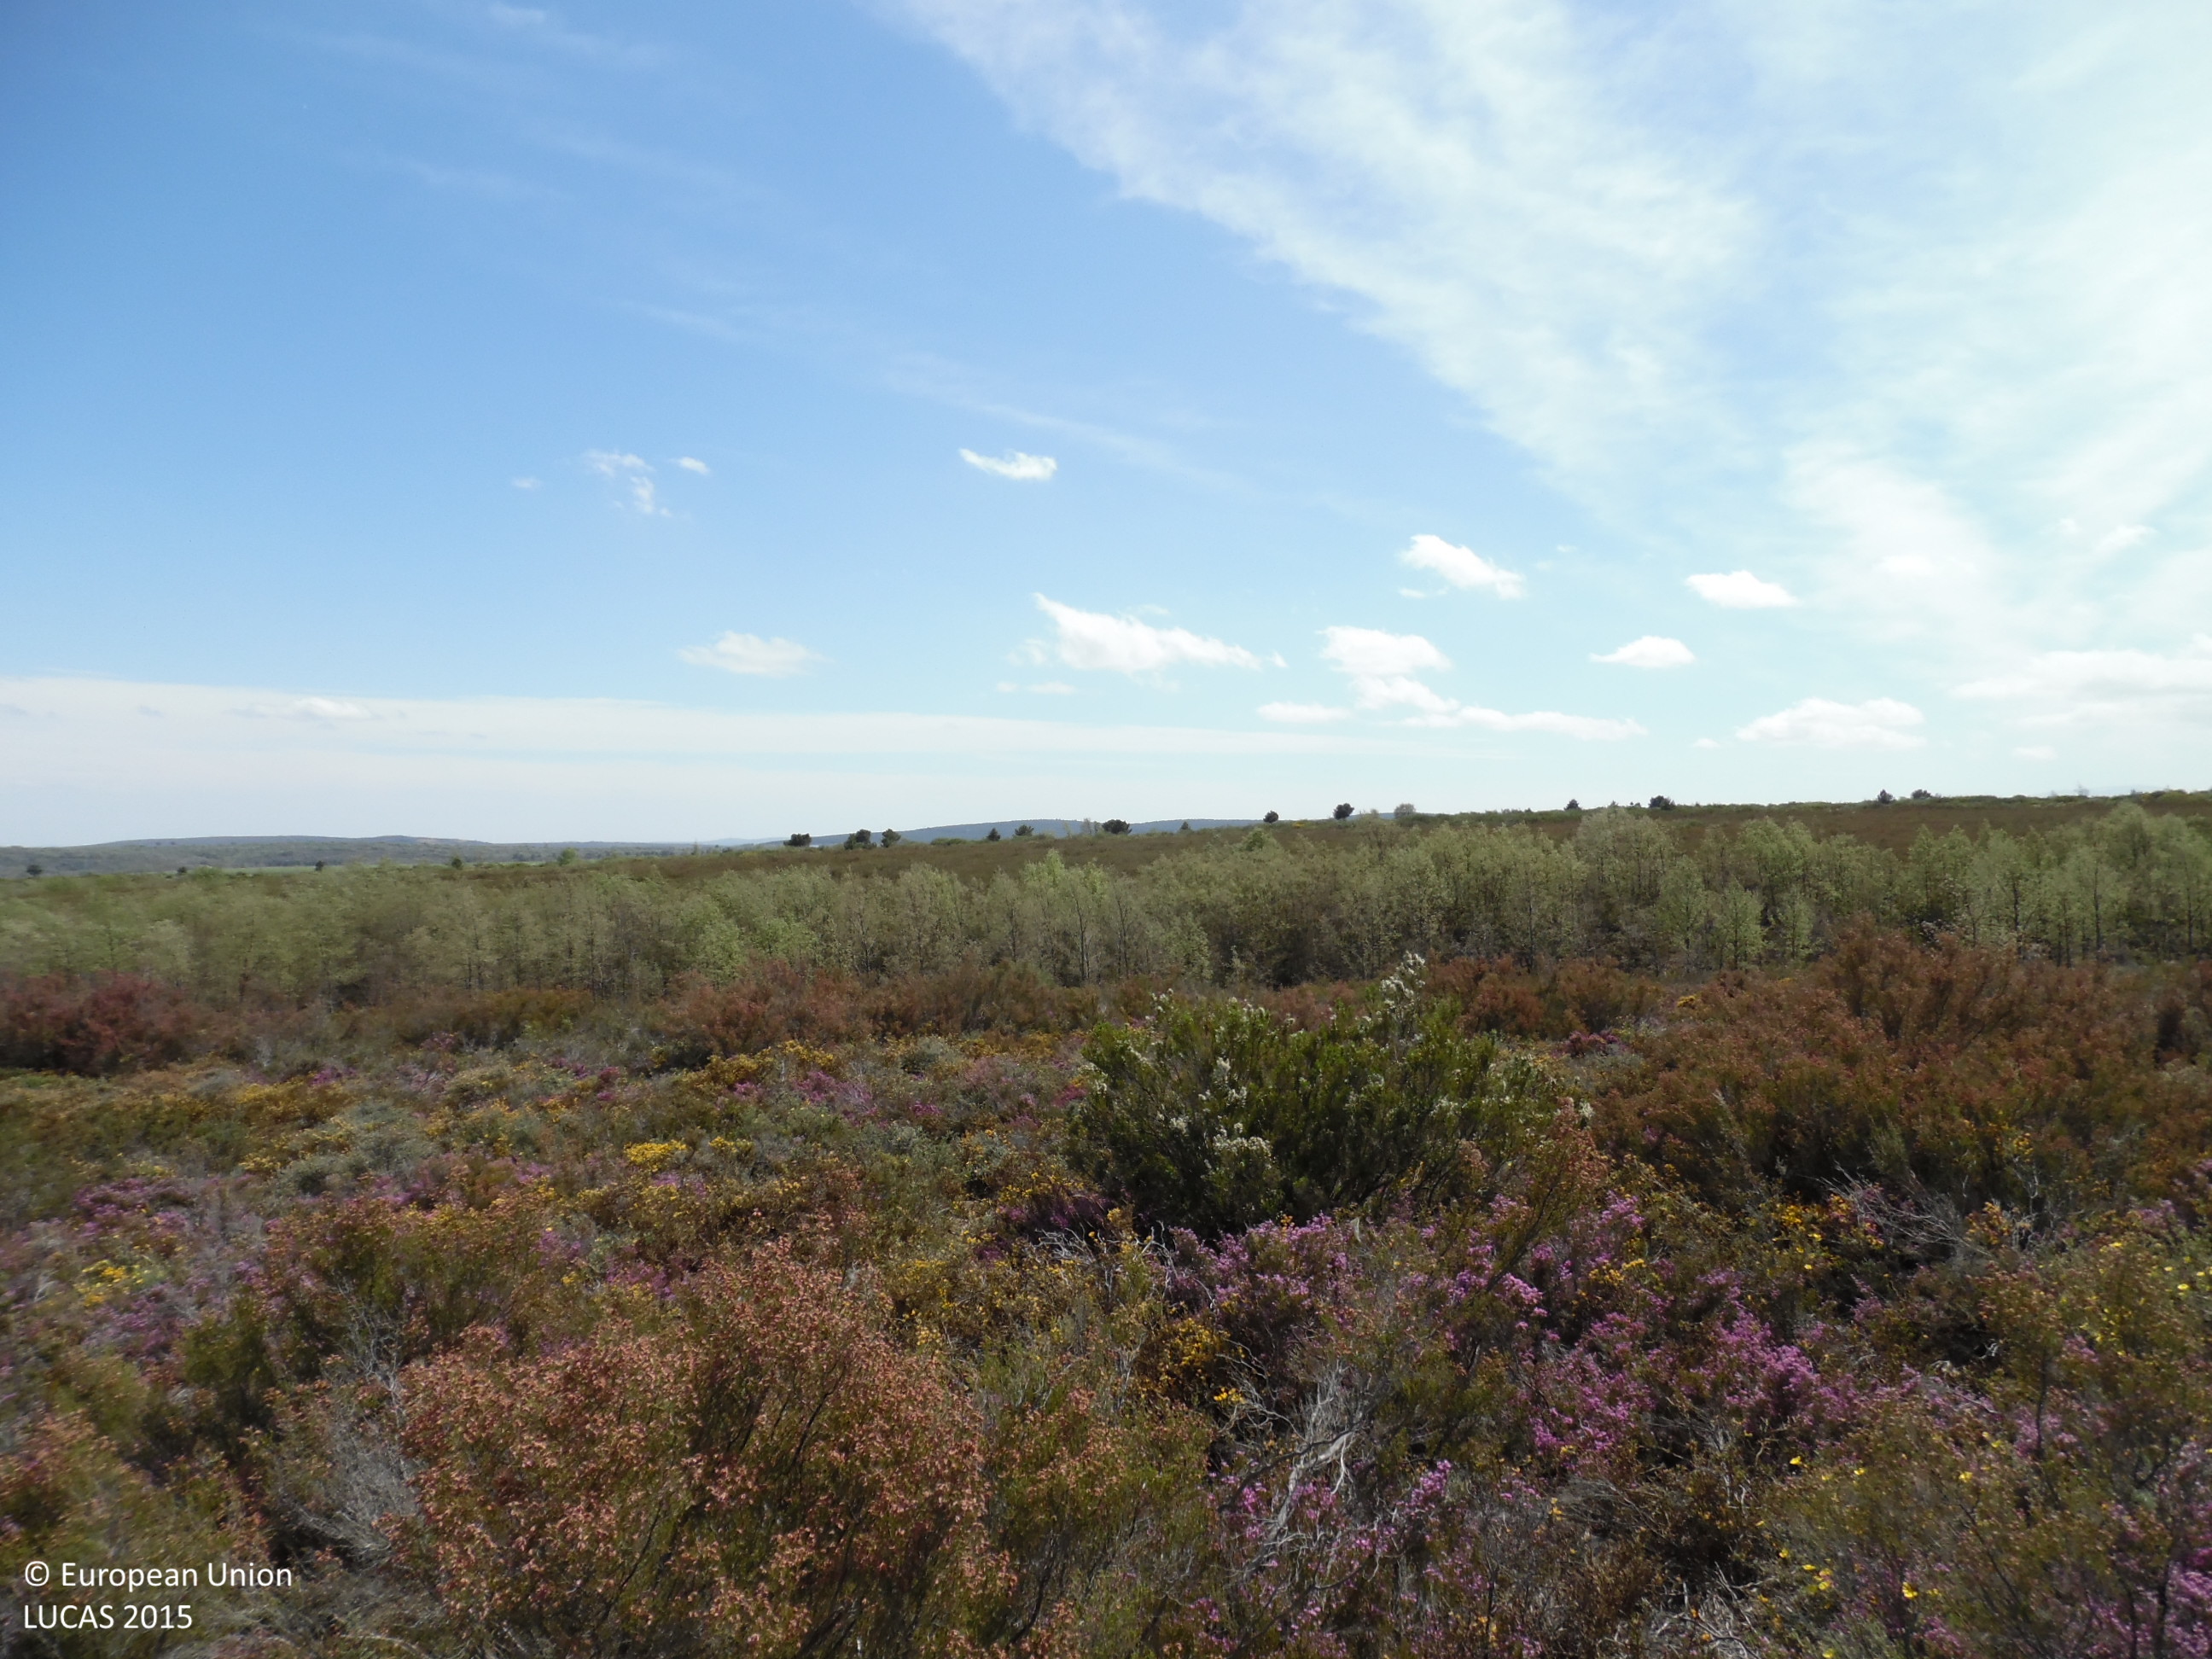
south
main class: Shrubland
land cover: Shrubland without tree cover
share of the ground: > 75 %
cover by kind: shrubs 100 %
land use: Abandoned areas
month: May
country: ES
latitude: 42.5647
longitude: -6.1270
